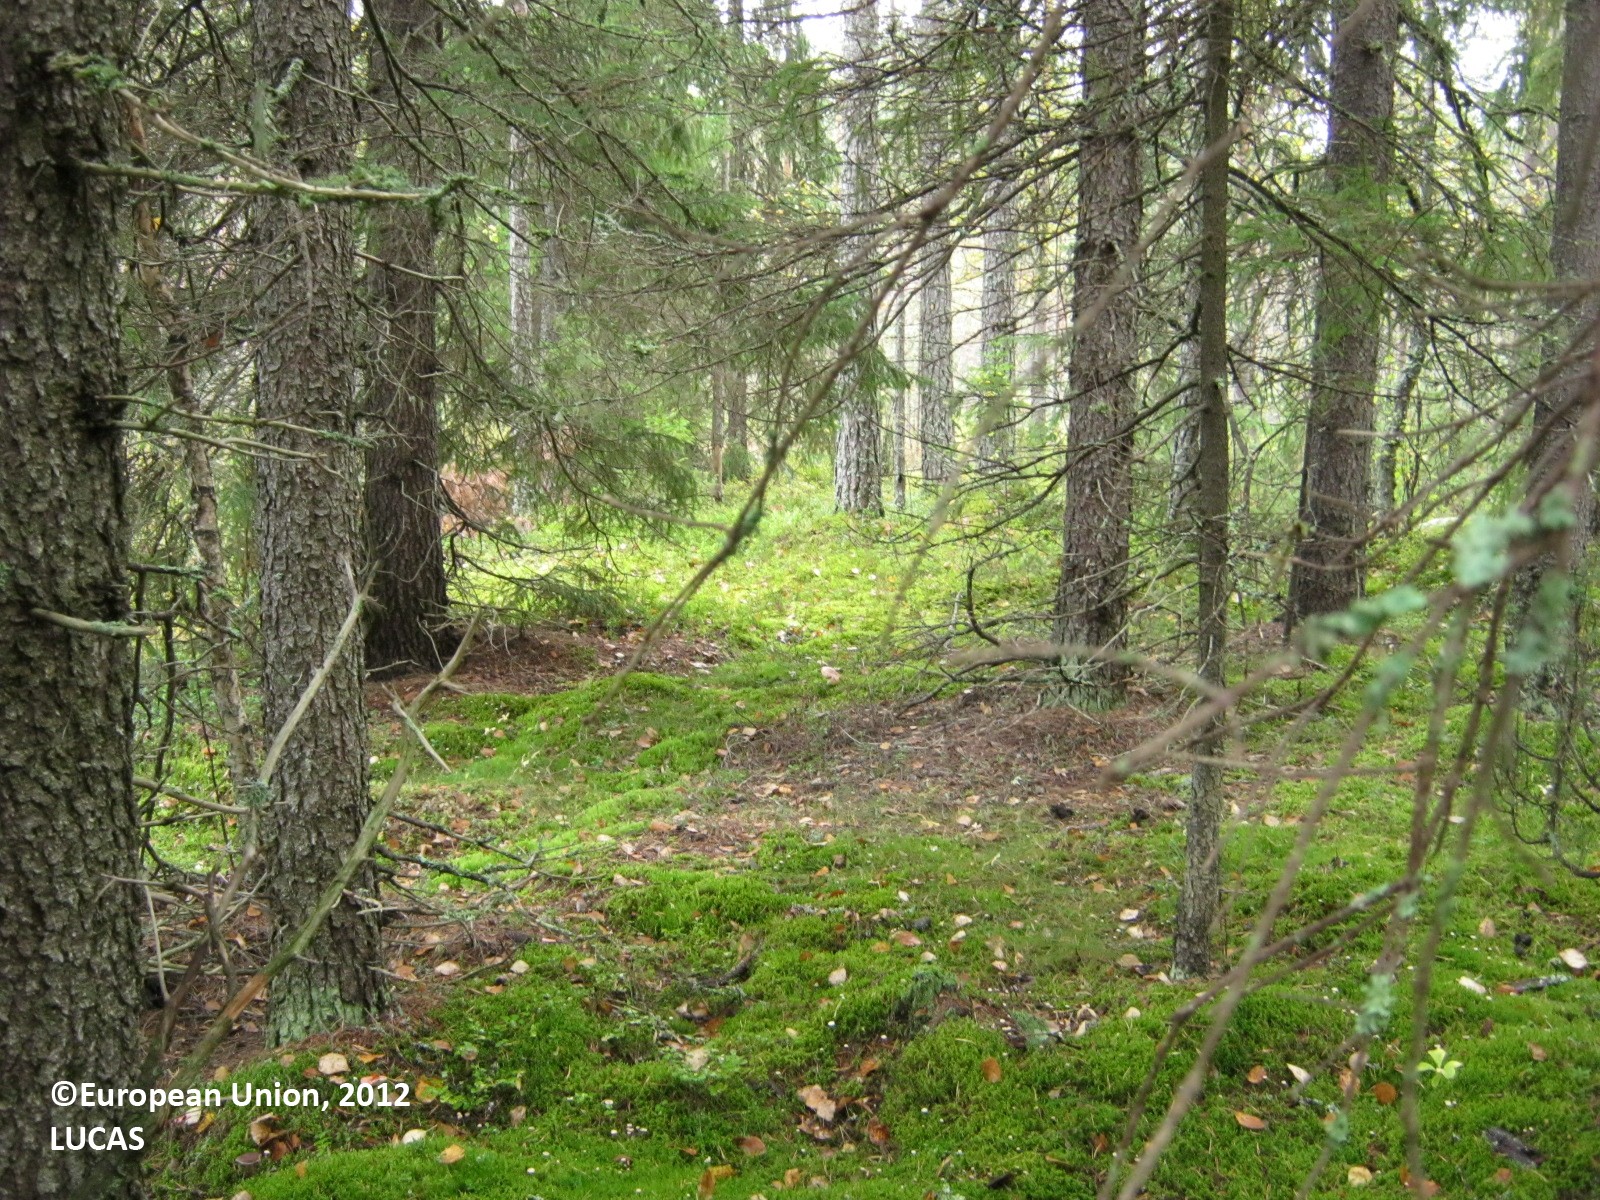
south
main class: Woodland
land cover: Spruce dominated coniferous woodland
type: boreal forest
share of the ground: 50 - 75 %
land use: Forestry
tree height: > 5 m
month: September
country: FI
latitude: 60.8808
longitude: 27.5570
